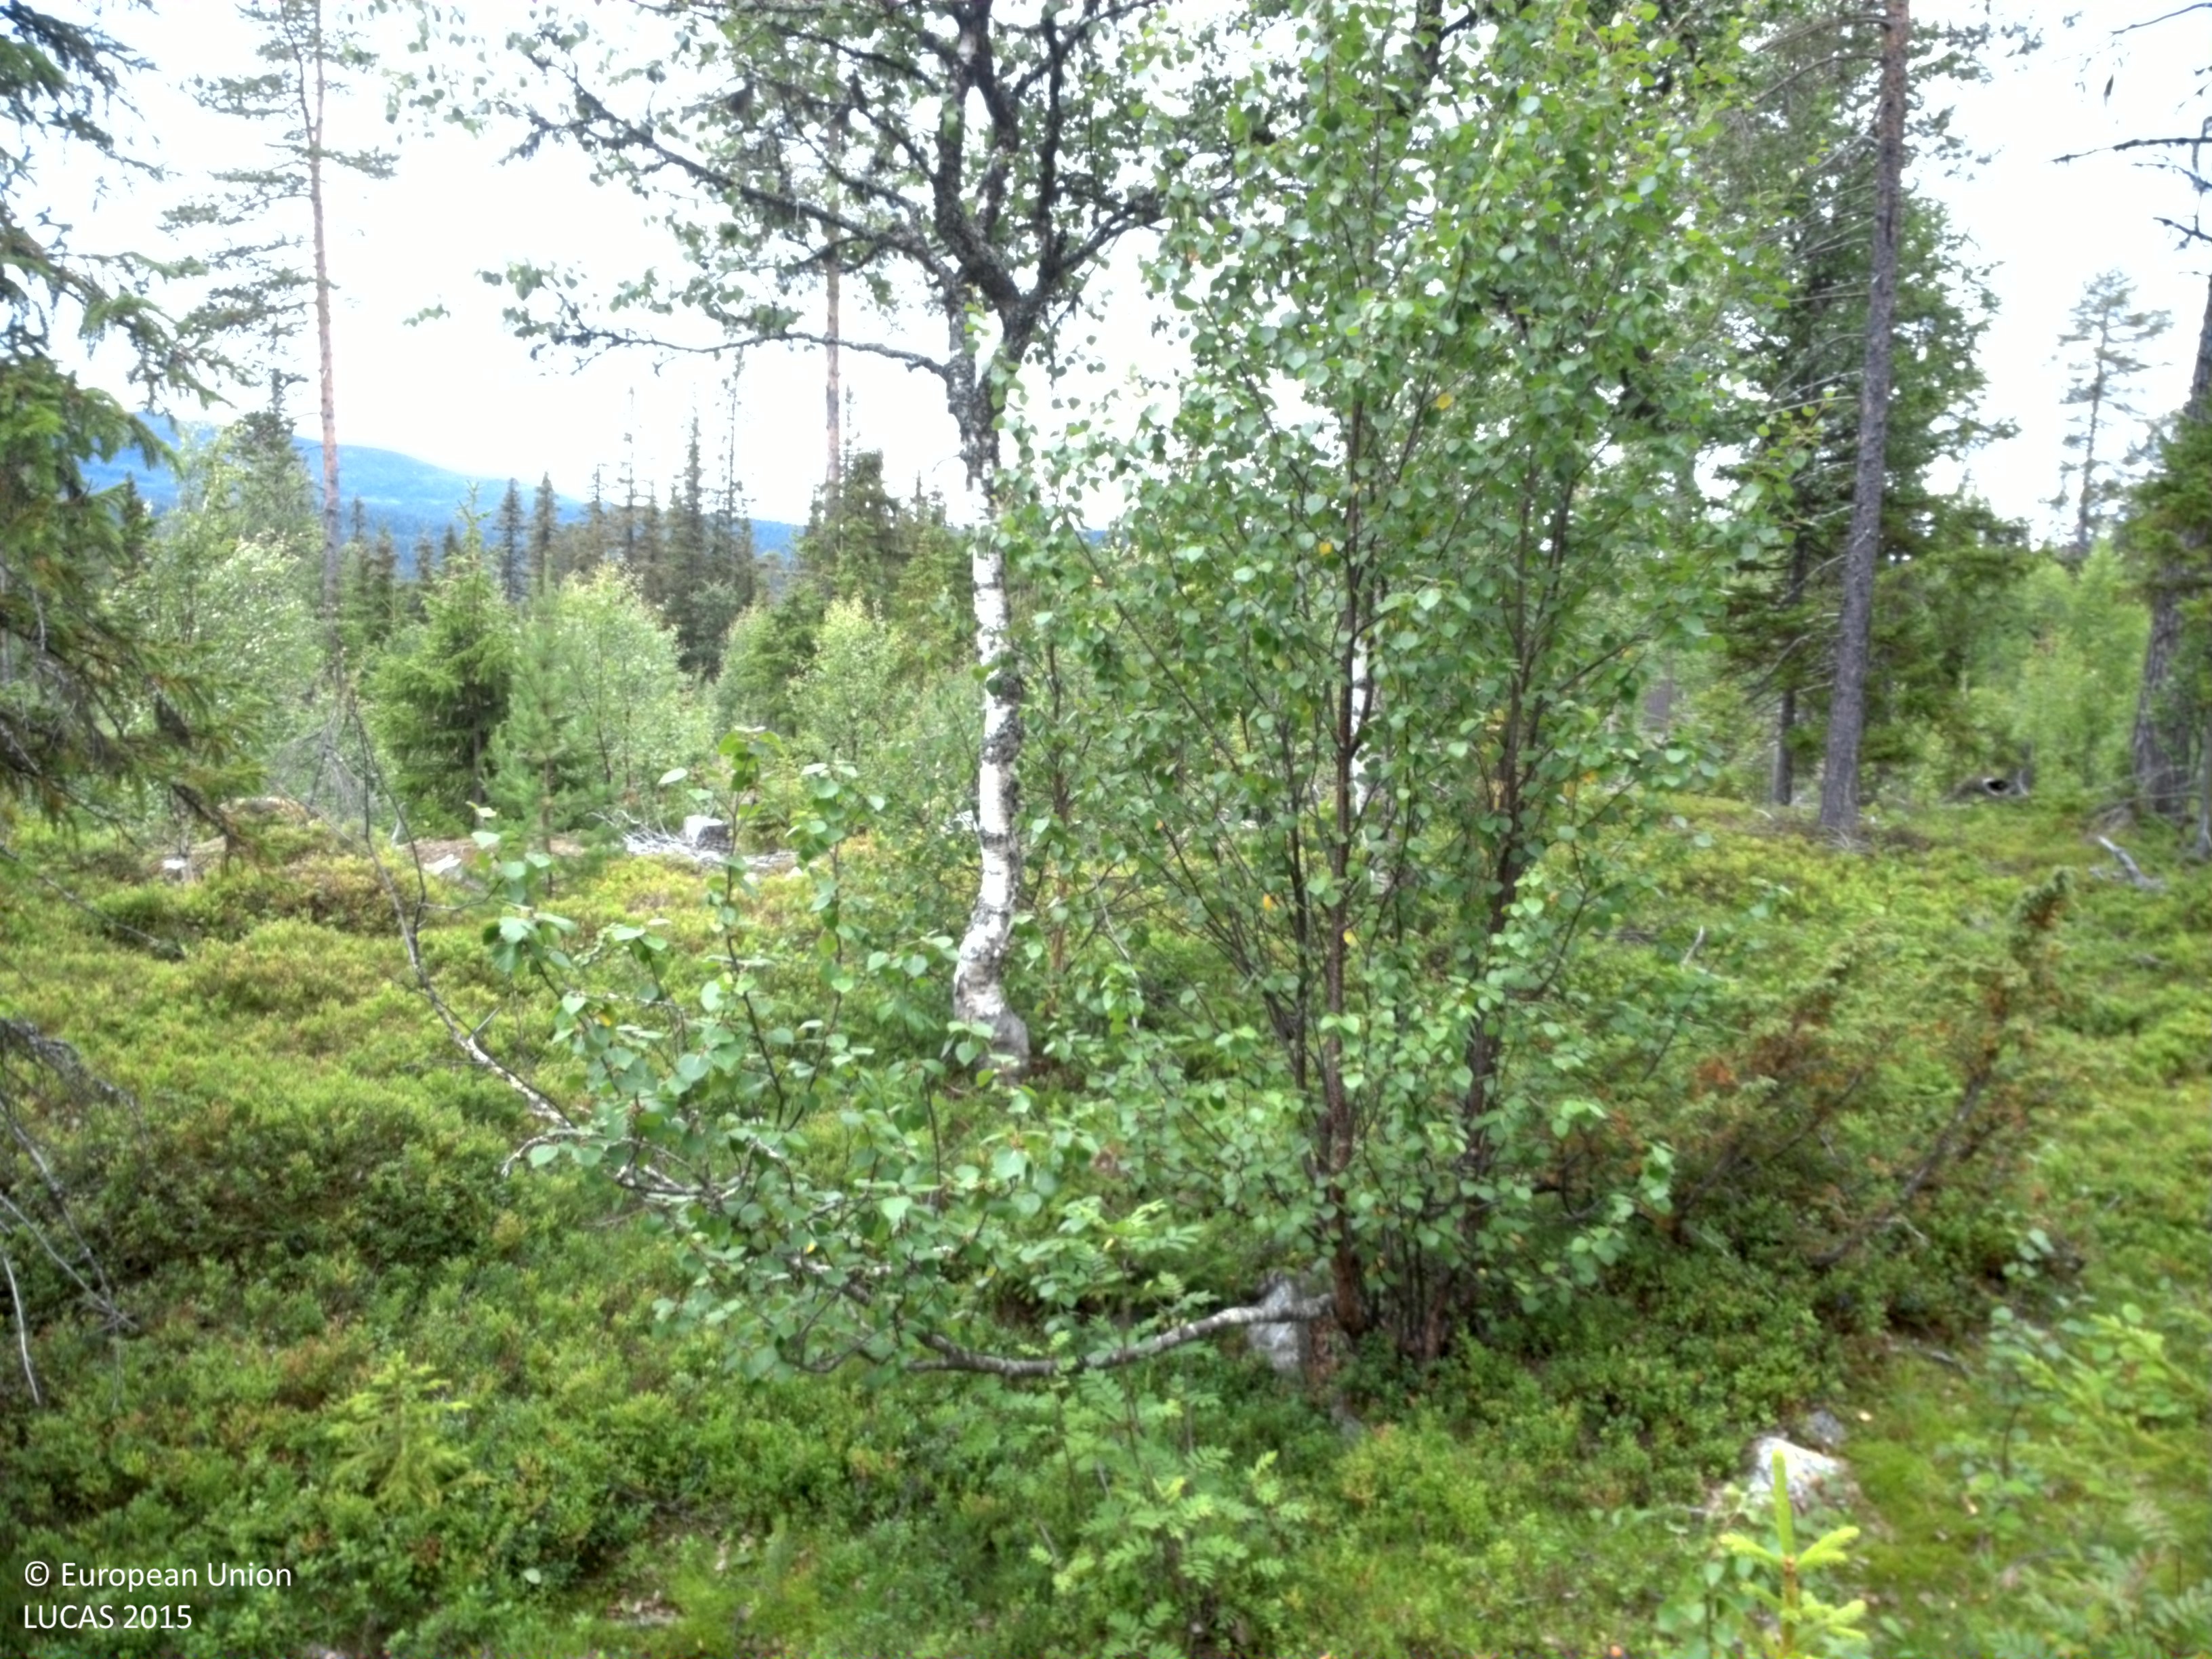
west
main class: Woodland
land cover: Other mixed woodland
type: boreal forest
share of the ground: 10 - 25 %
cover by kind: shrubs 65 %, coniferous forest trees 15 %, lichens and mosses 10 %, broadleaved forest trees 5 %, herbaceous plants 5 %
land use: Forestry
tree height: > 5 m
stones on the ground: < 10 %
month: August
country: SE
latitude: 64.9369
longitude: 15.4897
